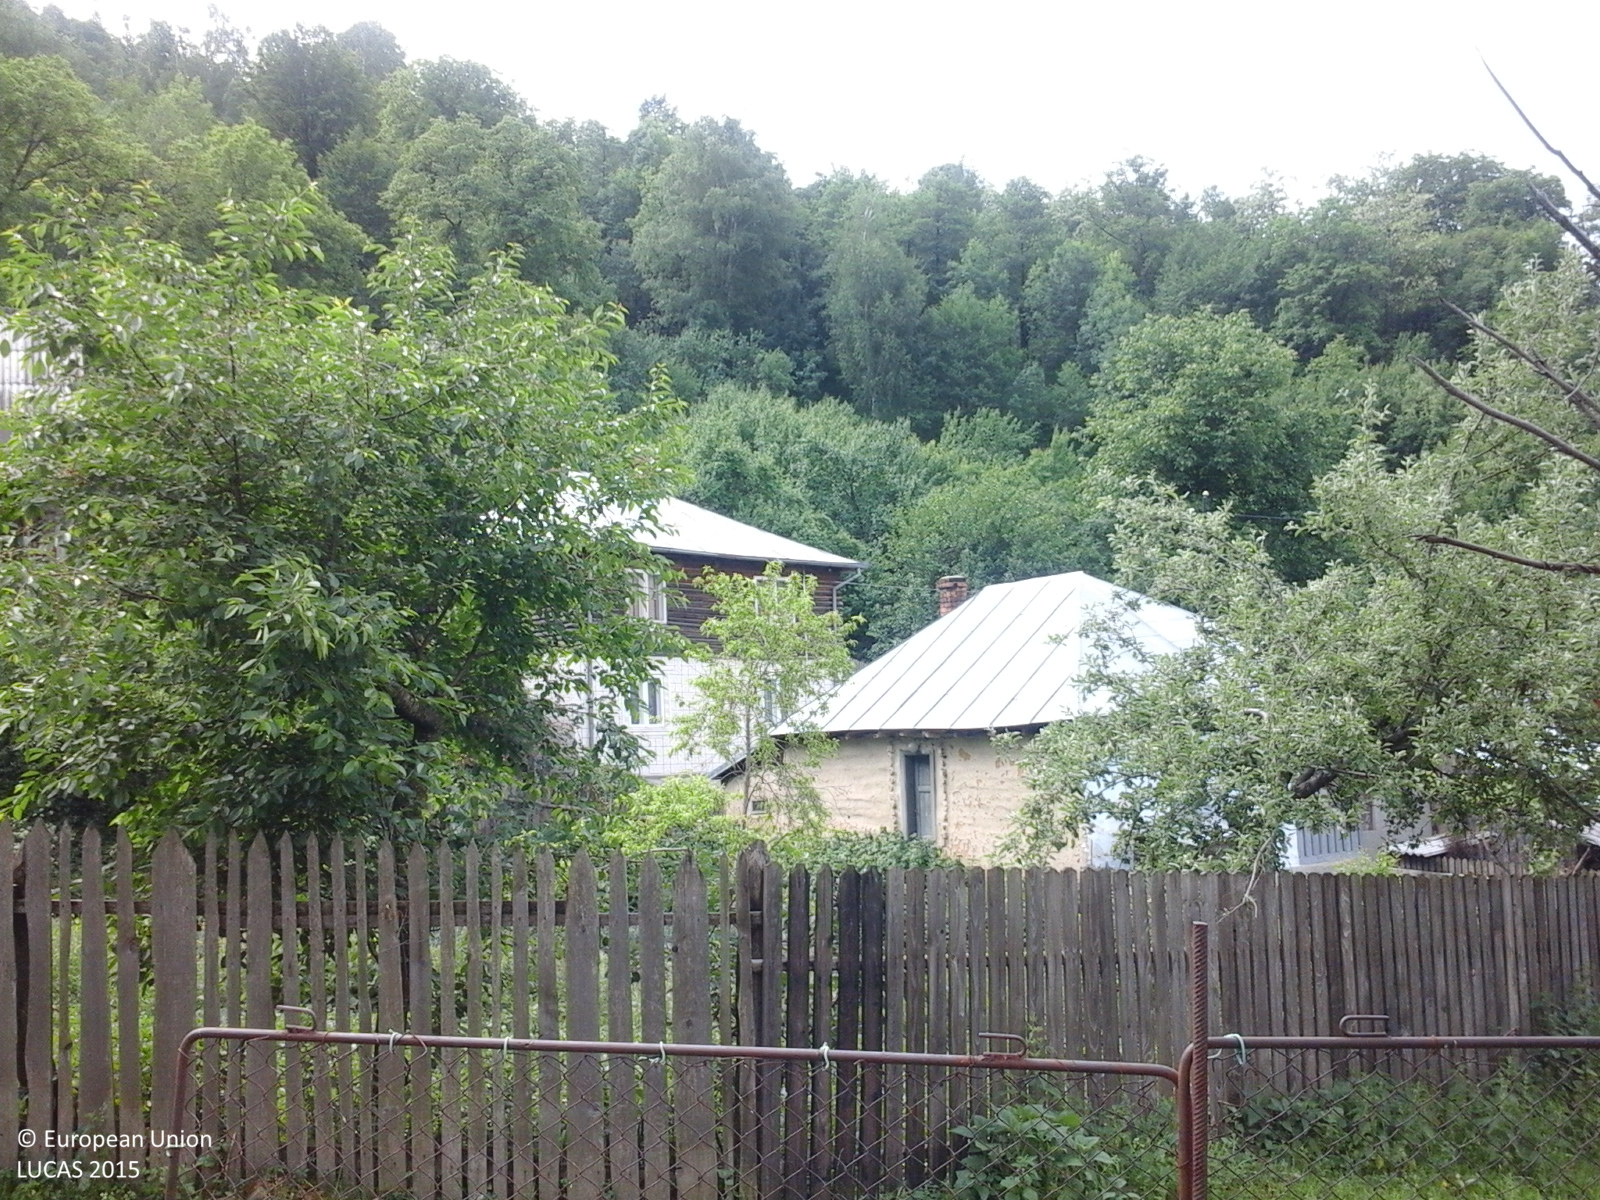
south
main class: Grassland
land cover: Grassland without tree/shrub cover
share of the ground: > 75 %
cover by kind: herbaceous plants 100 %
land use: Agriculture (excluding fallow land and kitchen gardens)
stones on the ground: < 10 %
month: May
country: RO
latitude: 45.4364
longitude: 26.3166
